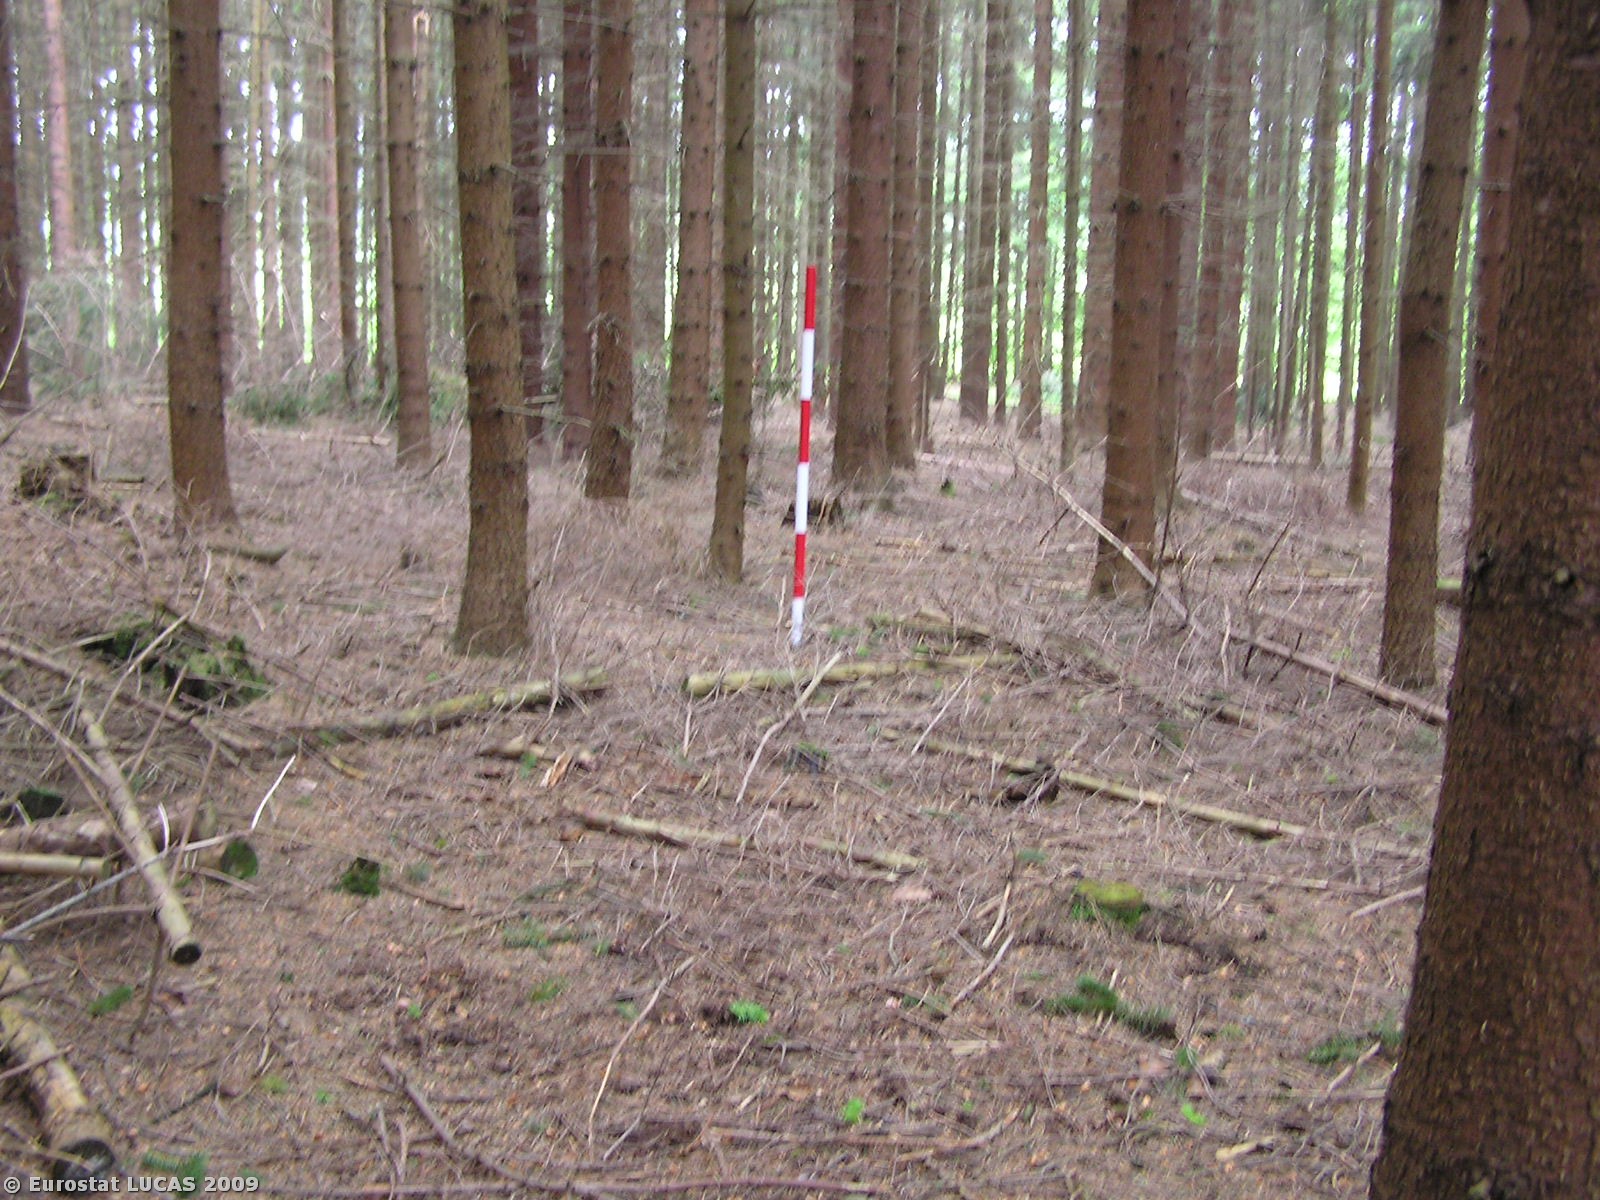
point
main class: Woodland
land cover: Coniferous woodland
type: hemiboreal forest and nemoral coniferous forest and mixed broadleaved-coniferous forest
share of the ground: > 75 %
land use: Forestry
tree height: > 5 m
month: May
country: CZ
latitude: 49.3192
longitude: 14.9686
